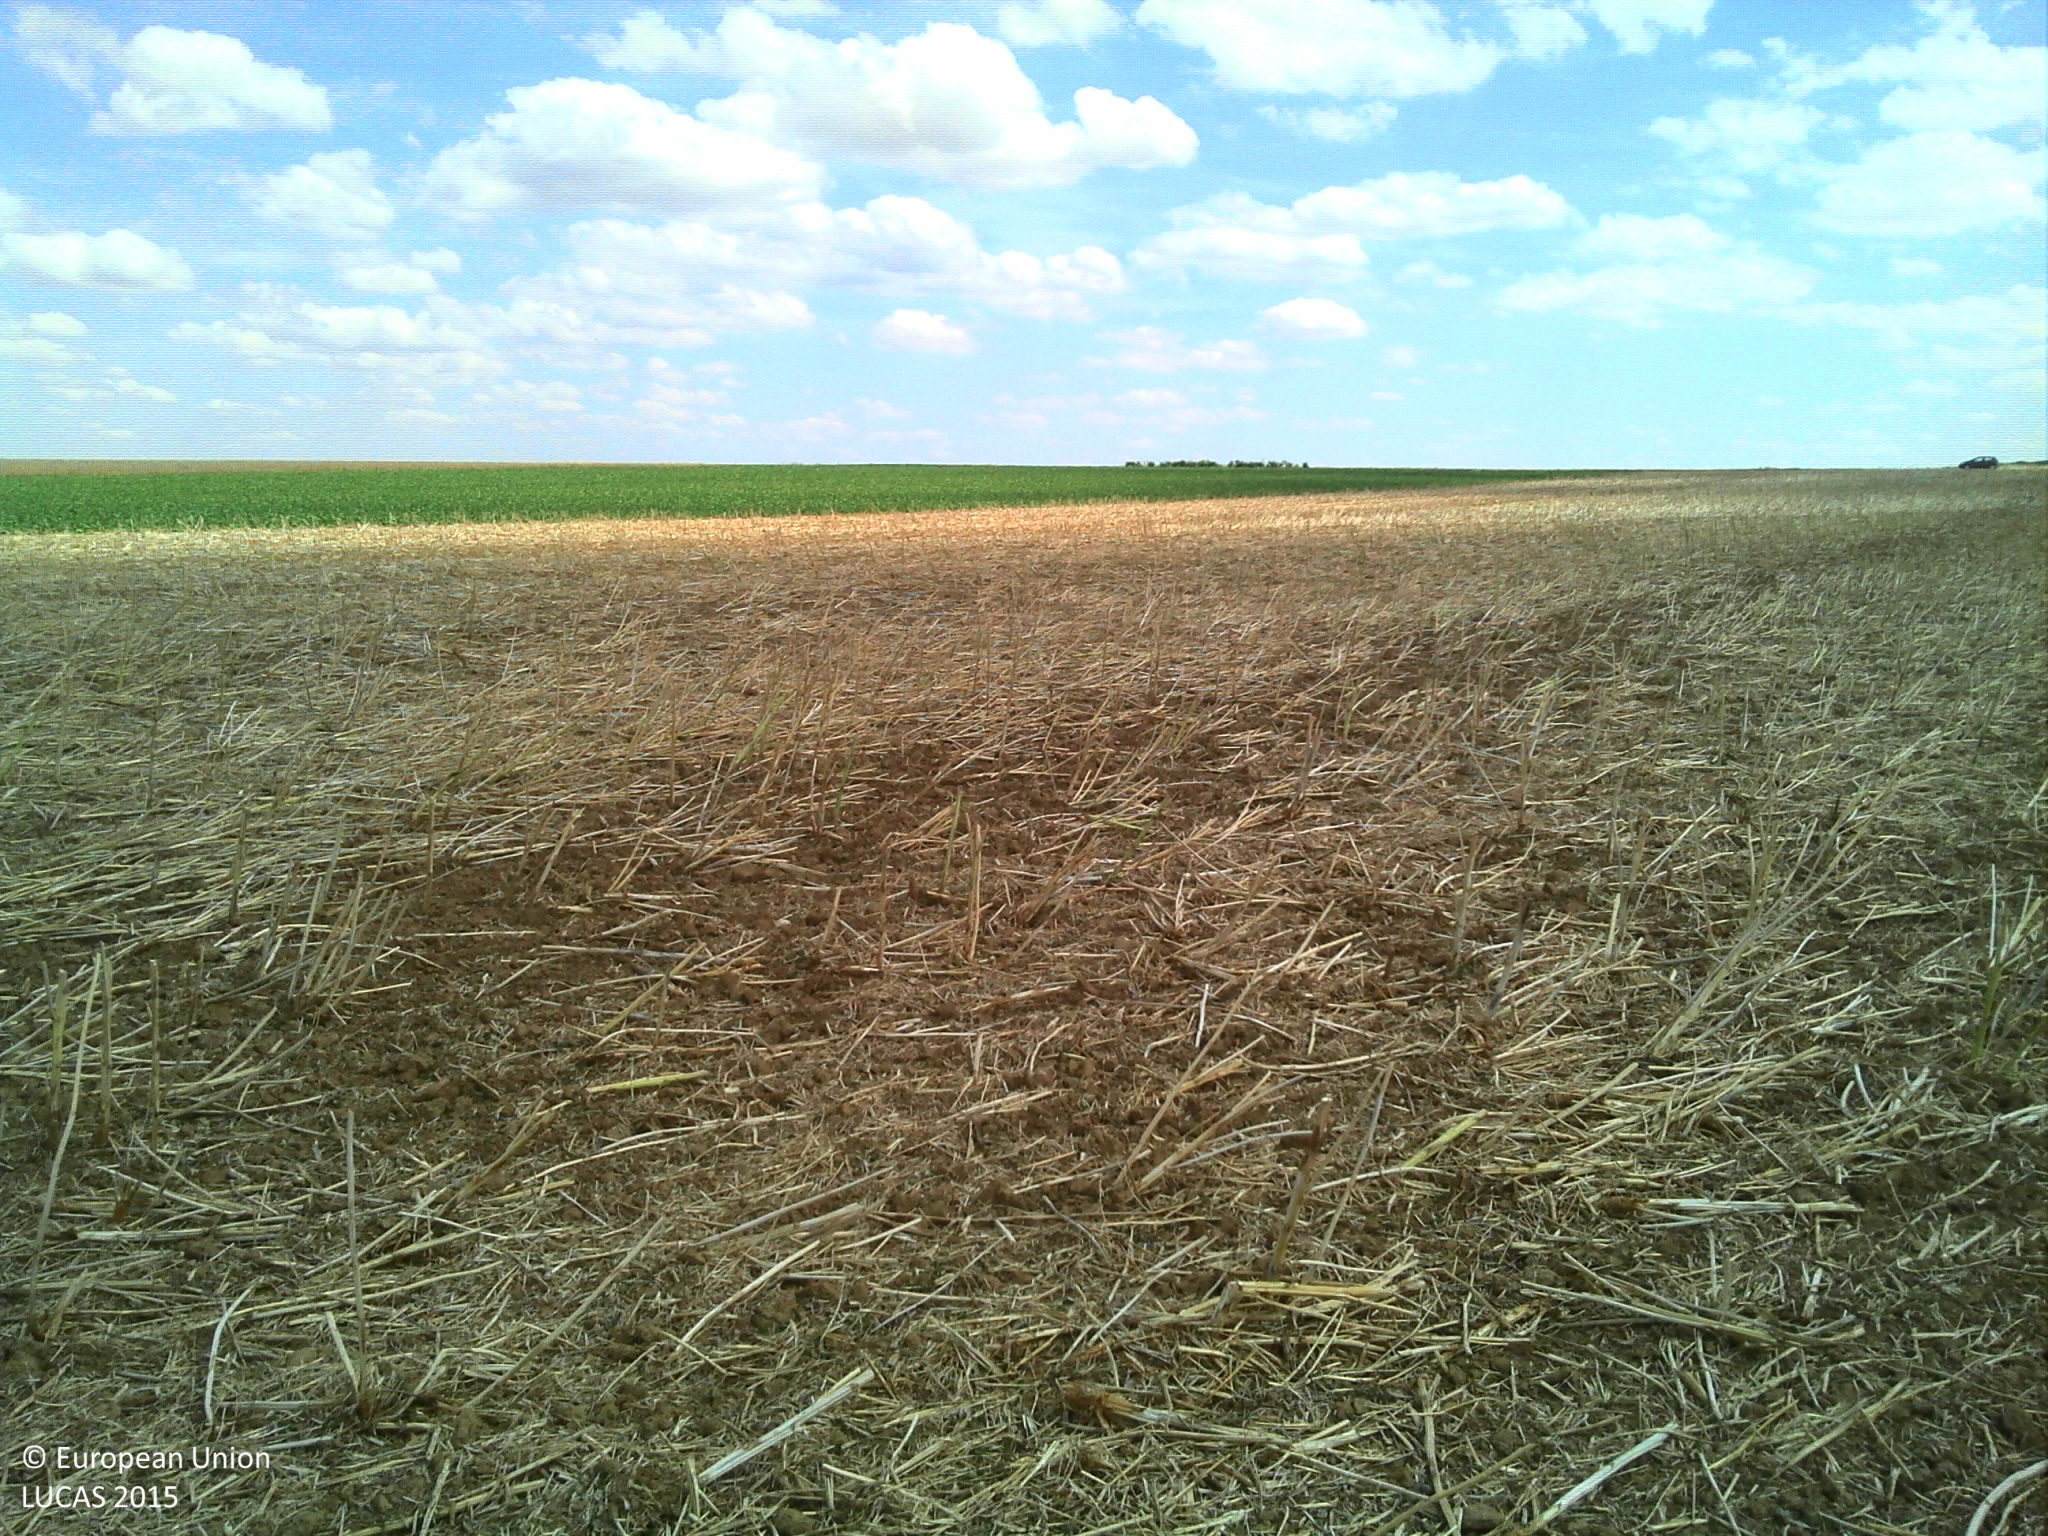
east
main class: Cropland
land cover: Rape and turnip rape
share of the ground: > 75 %
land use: Agriculture (excluding fallow land and kitchen gardens)
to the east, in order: Rape and turnip rape; Sugar beet
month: August
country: FR
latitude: 48.6418
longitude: 3.4384
